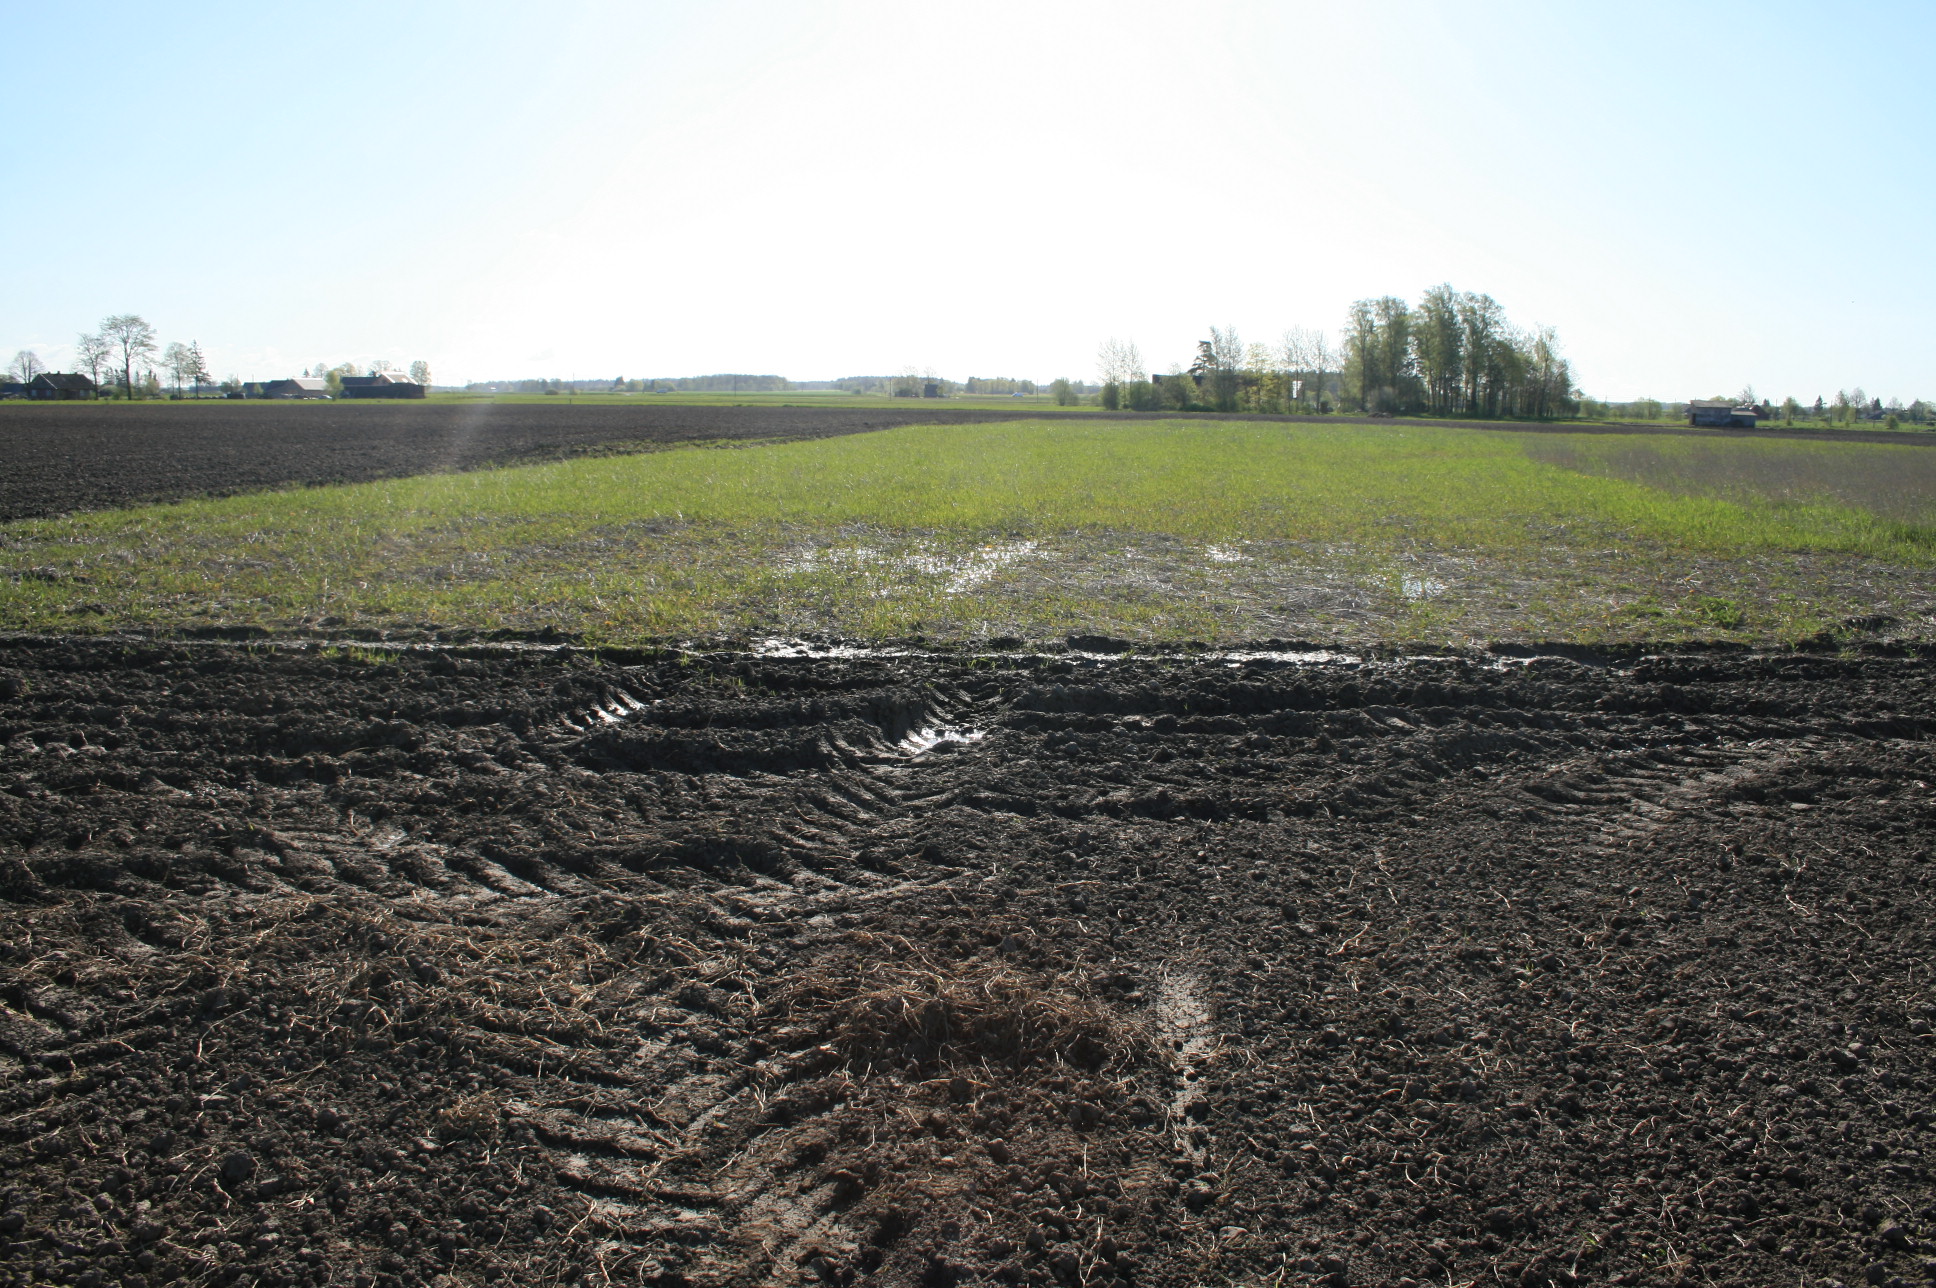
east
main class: Cropland
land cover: Dry pulses
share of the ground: < 10 %
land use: Agriculture (excluding fallow land and kitchen gardens)
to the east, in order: Dry pulses; Grassland without tree/shrub cover; Dry pulses; Grassland without tree/shrub cover
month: May
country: LT
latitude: 56.2490
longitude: 21.5181
